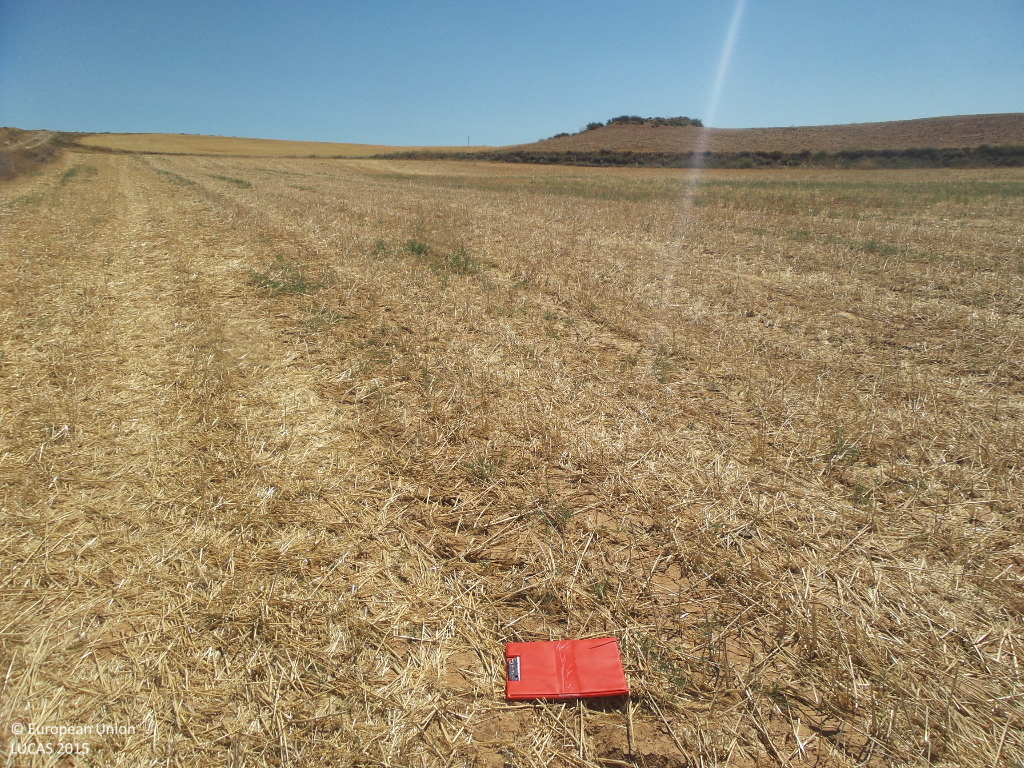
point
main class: Cropland
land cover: Common wheat
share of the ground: < 10 %
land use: Agriculture (excluding fallow land and kitchen gardens)
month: July
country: ES
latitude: 41.3405
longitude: -2.1113
